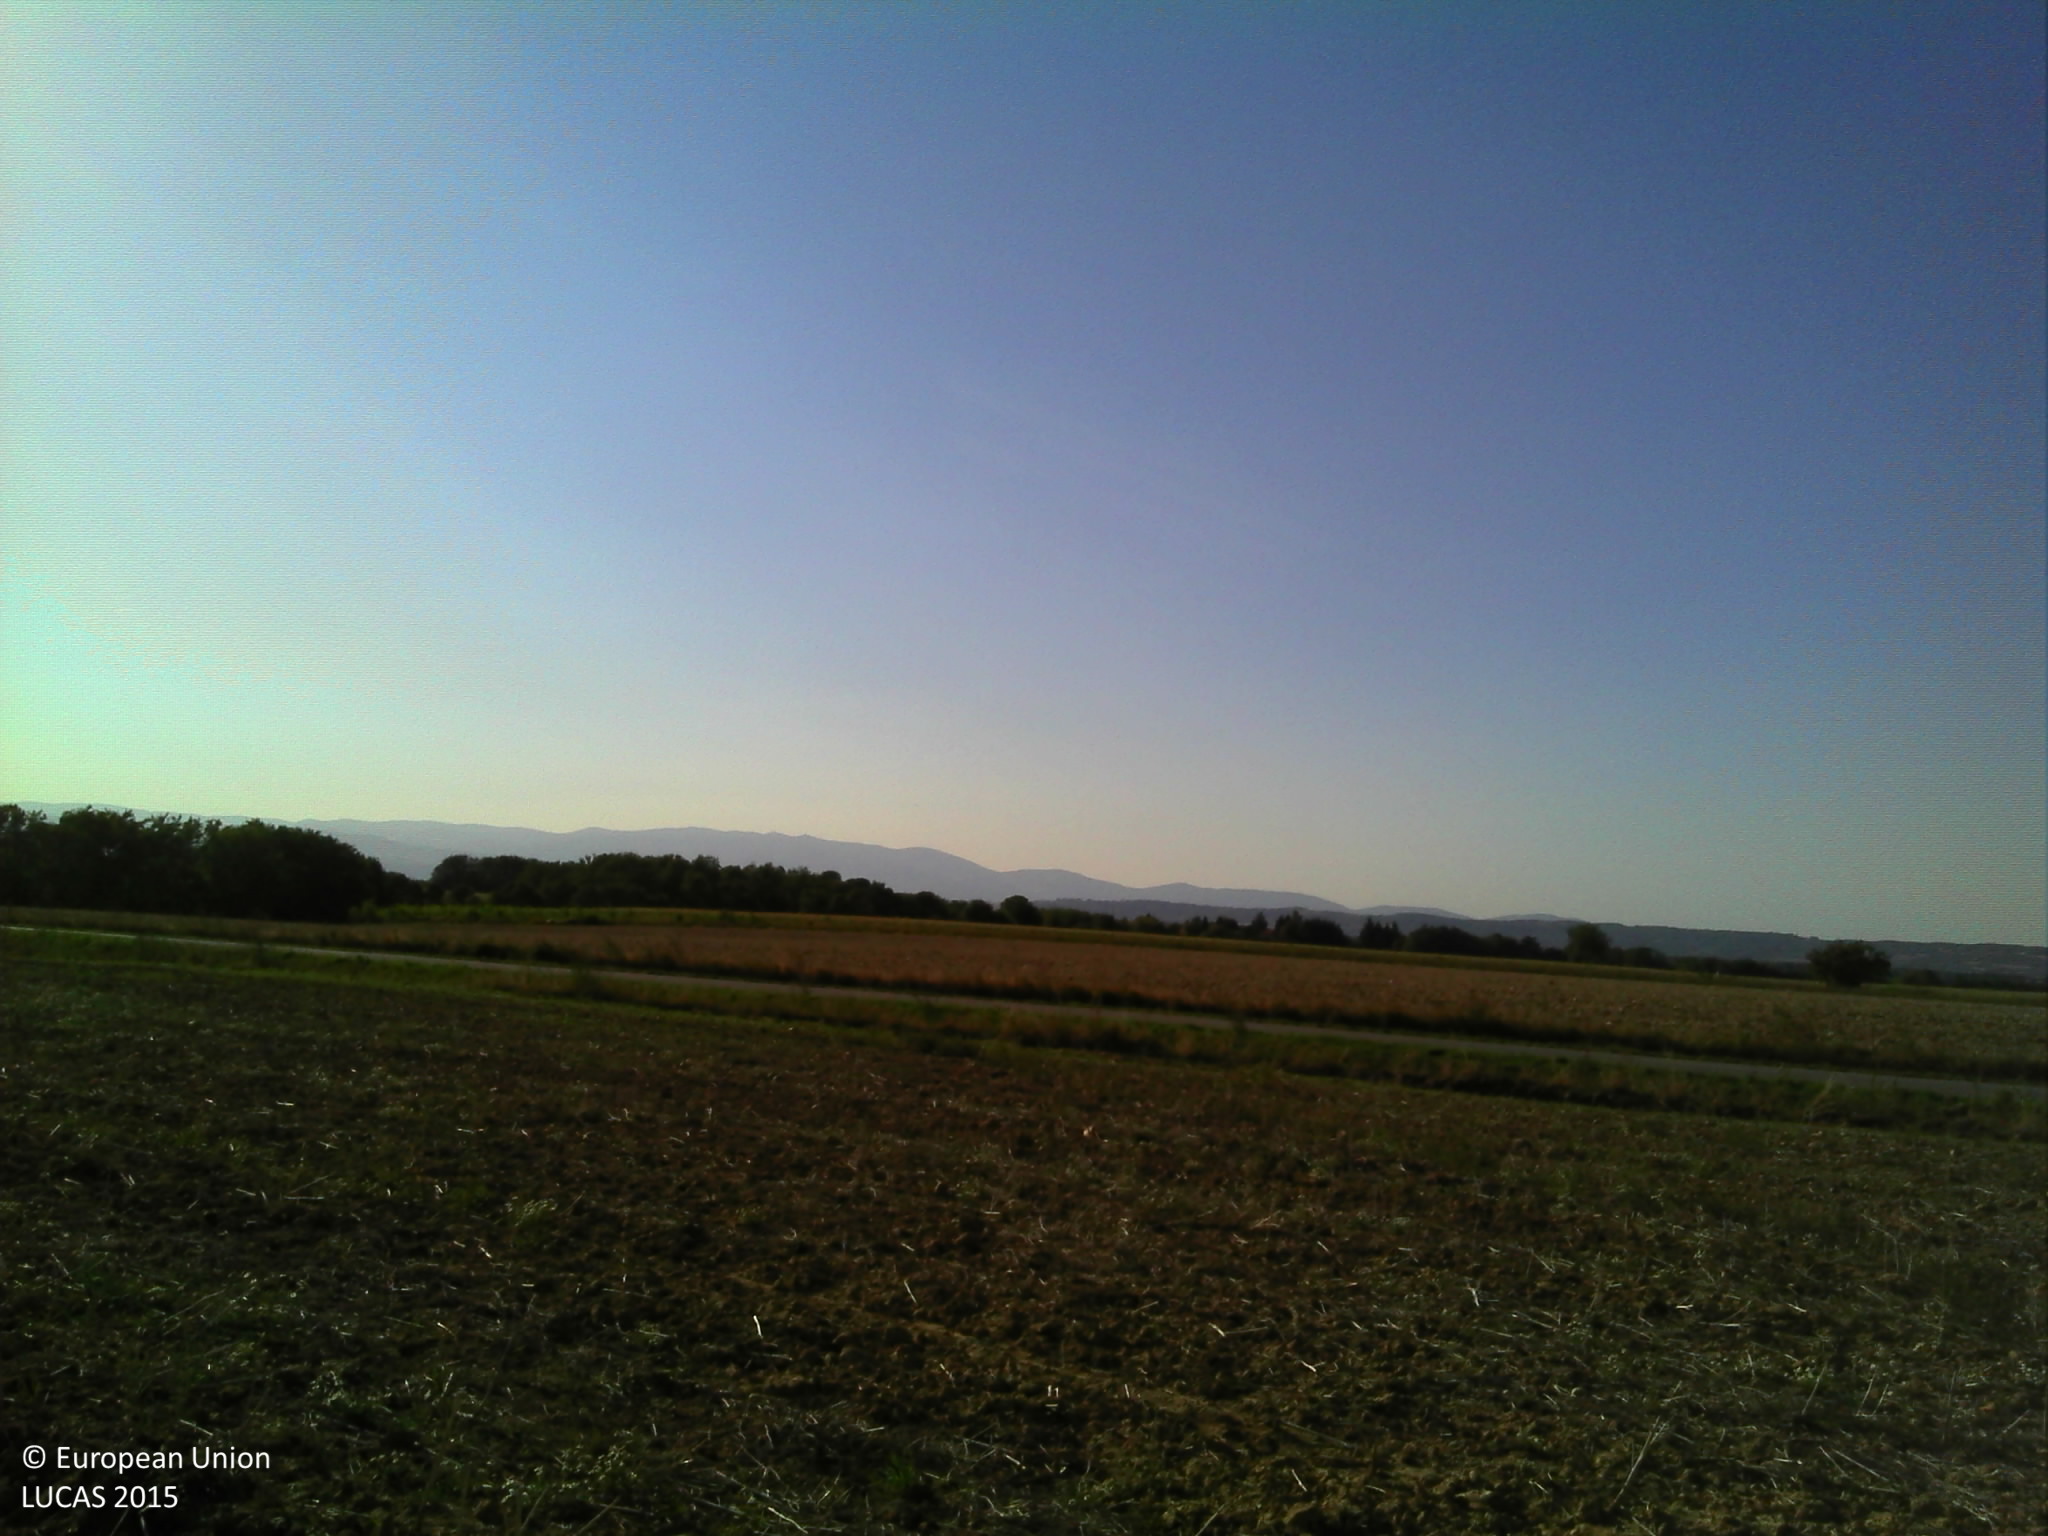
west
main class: Cropland
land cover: Rape and turnip rape
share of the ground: < 10 %
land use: Agriculture (excluding fallow land and kitchen gardens)
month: September
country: FR
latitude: 45.2966
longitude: 5.0189
